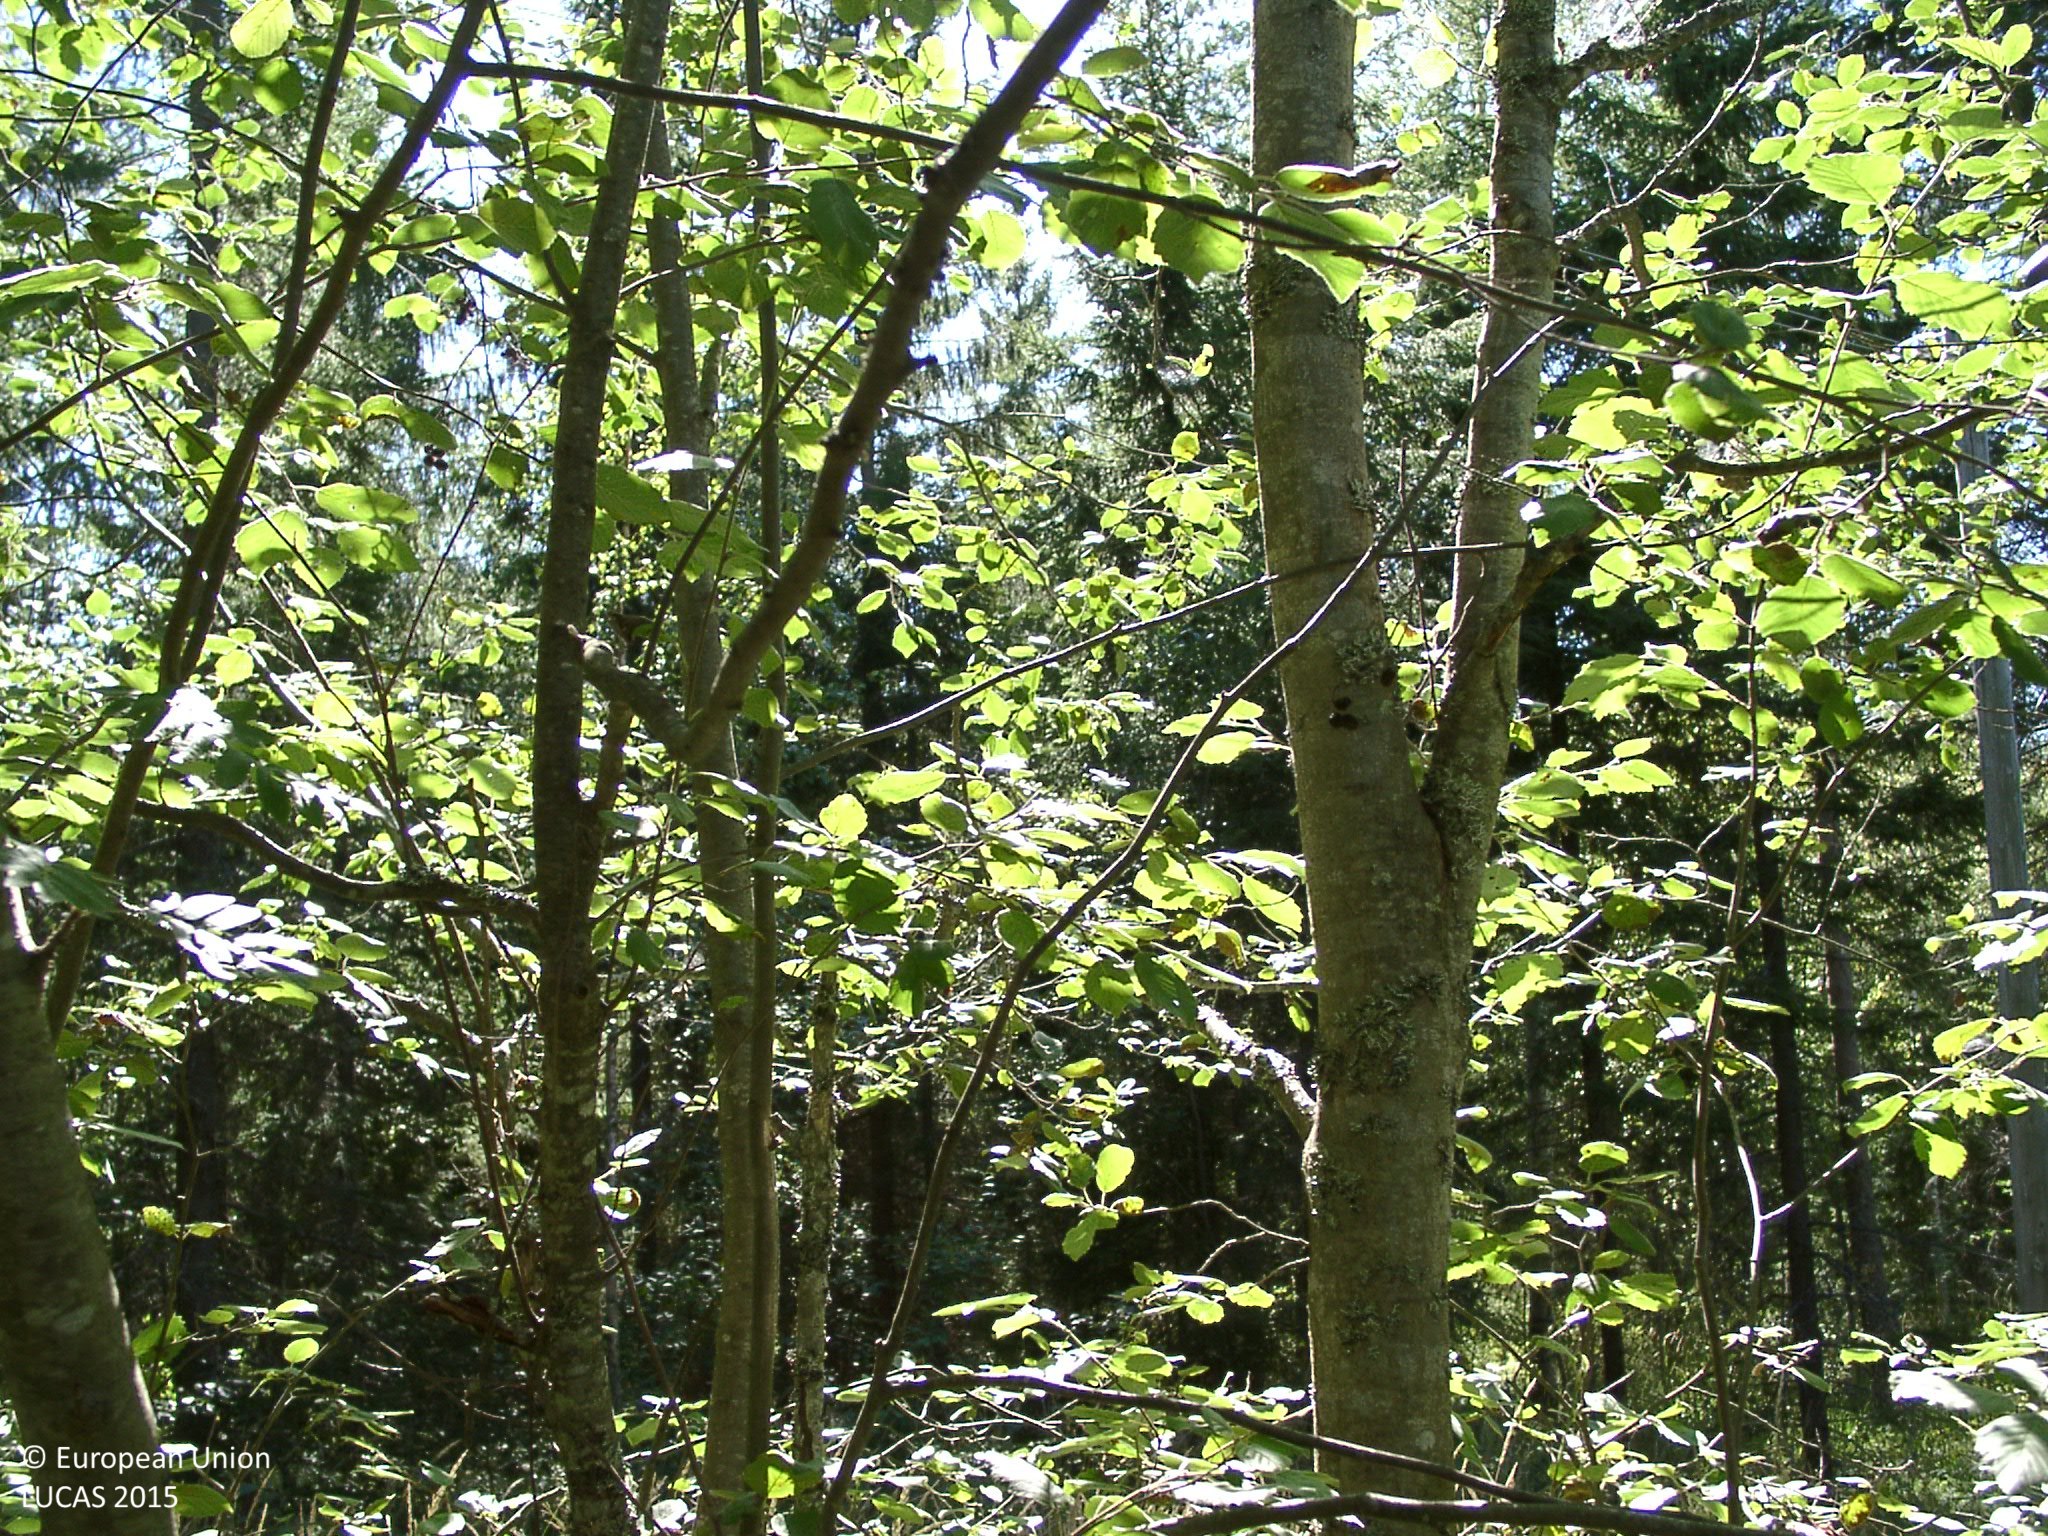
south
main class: Woodland
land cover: Broadleaved woodland
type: boreal forest
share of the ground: 50 - 75 %
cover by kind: broadleaved forest trees 50 %, herbaceous plants 25 %, coniferous forest trees 15 %, shrubs 10 %
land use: Forestry
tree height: < 5 m
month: August
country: FI
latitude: 61.9239
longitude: 24.8635
